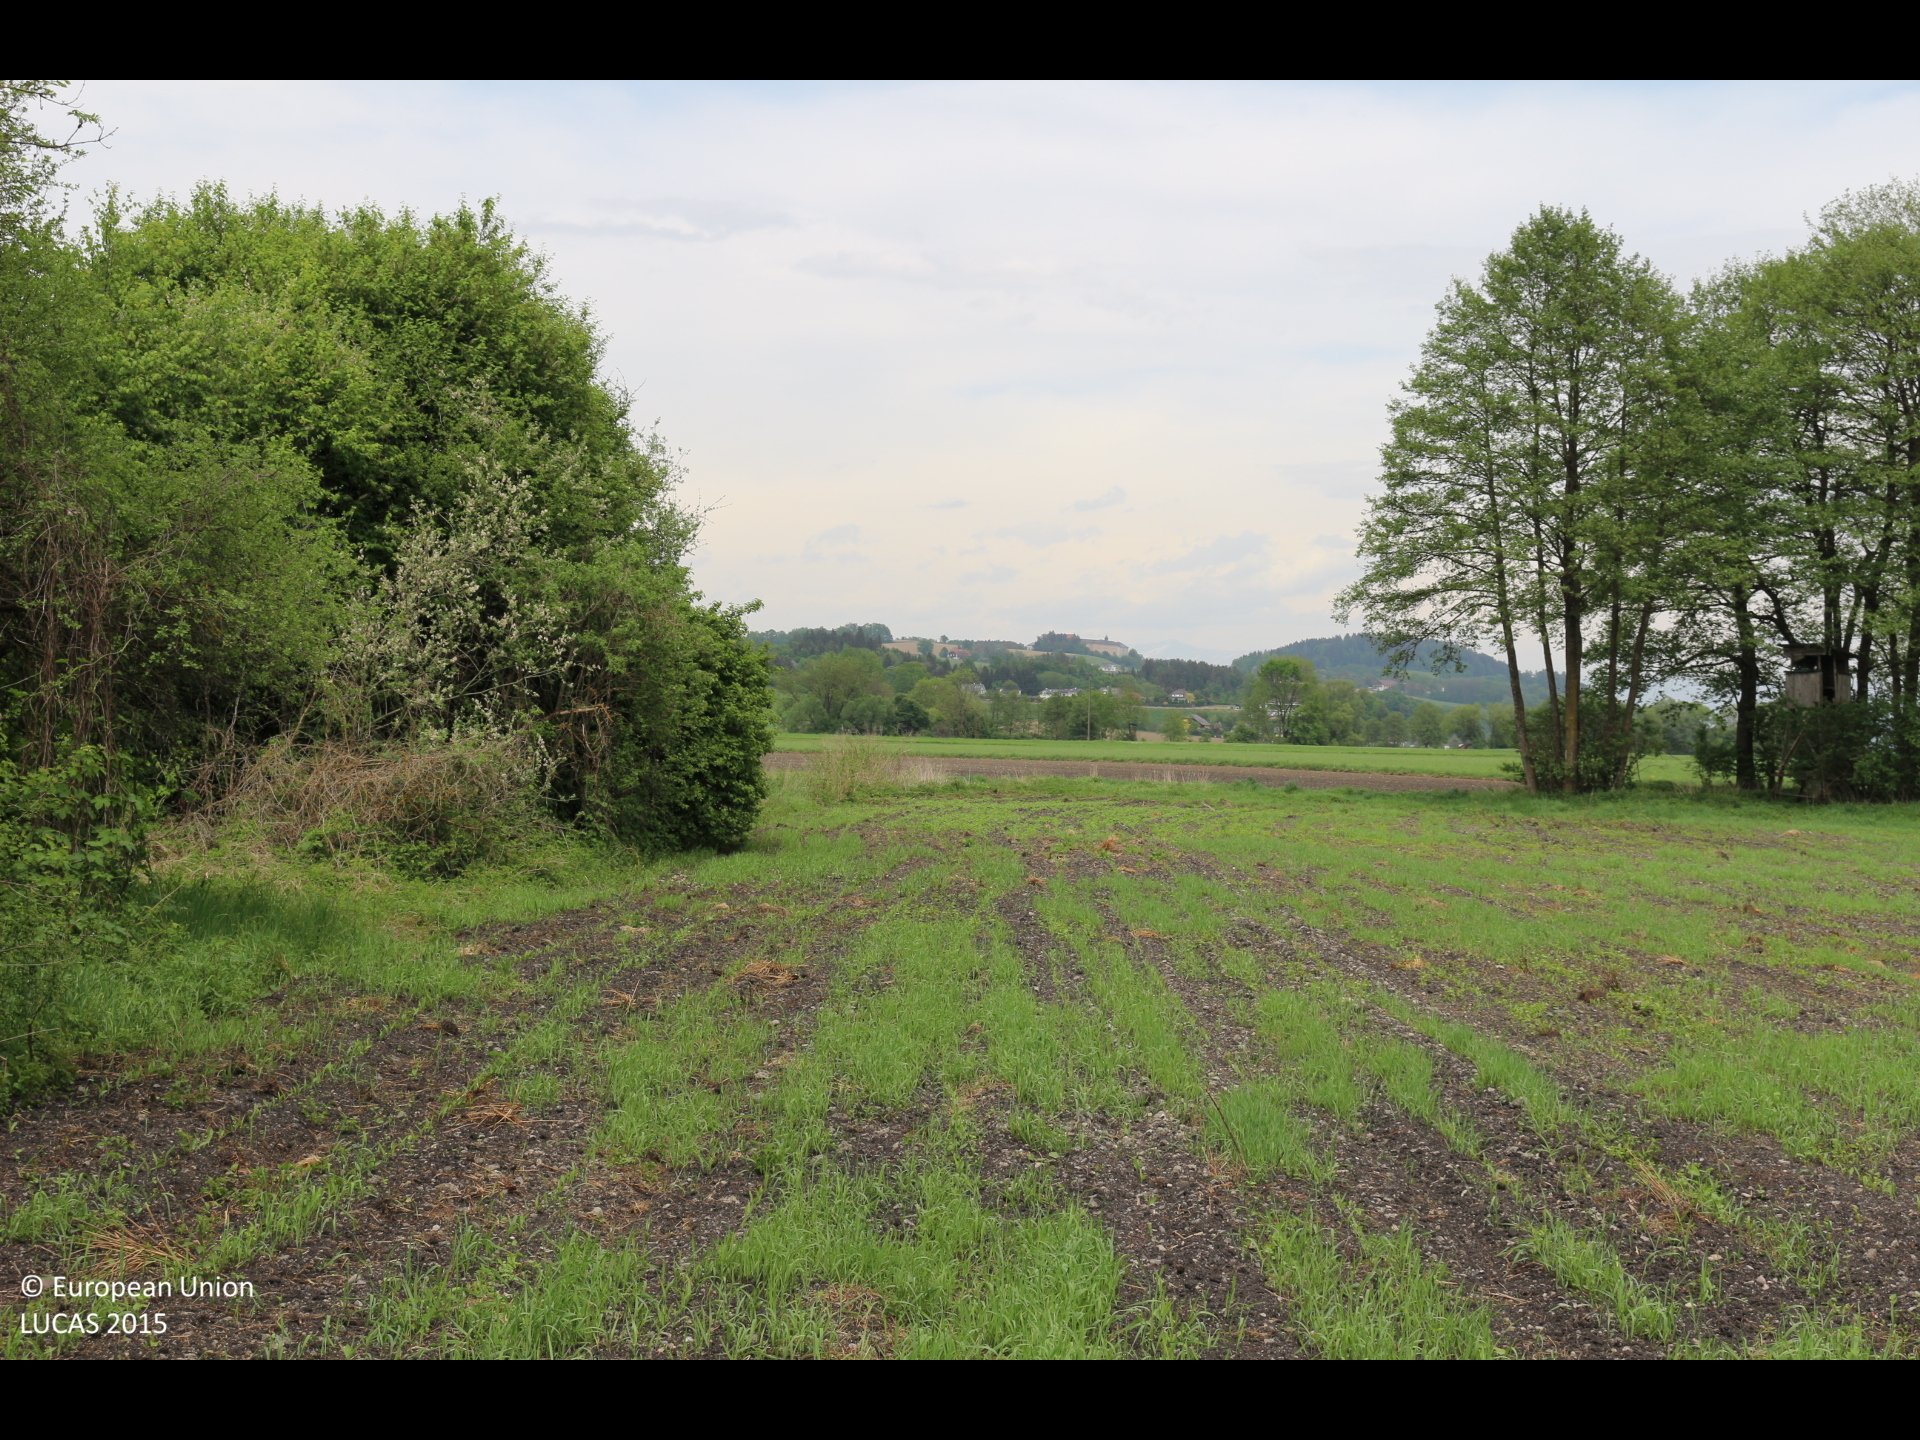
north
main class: Cropland
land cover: Common wheat
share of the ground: 25 - 50 %
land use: Agriculture (excluding fallow land and kitchen gardens)
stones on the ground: < 10 %
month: May
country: AT
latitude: 46.6786
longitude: 14.3247
